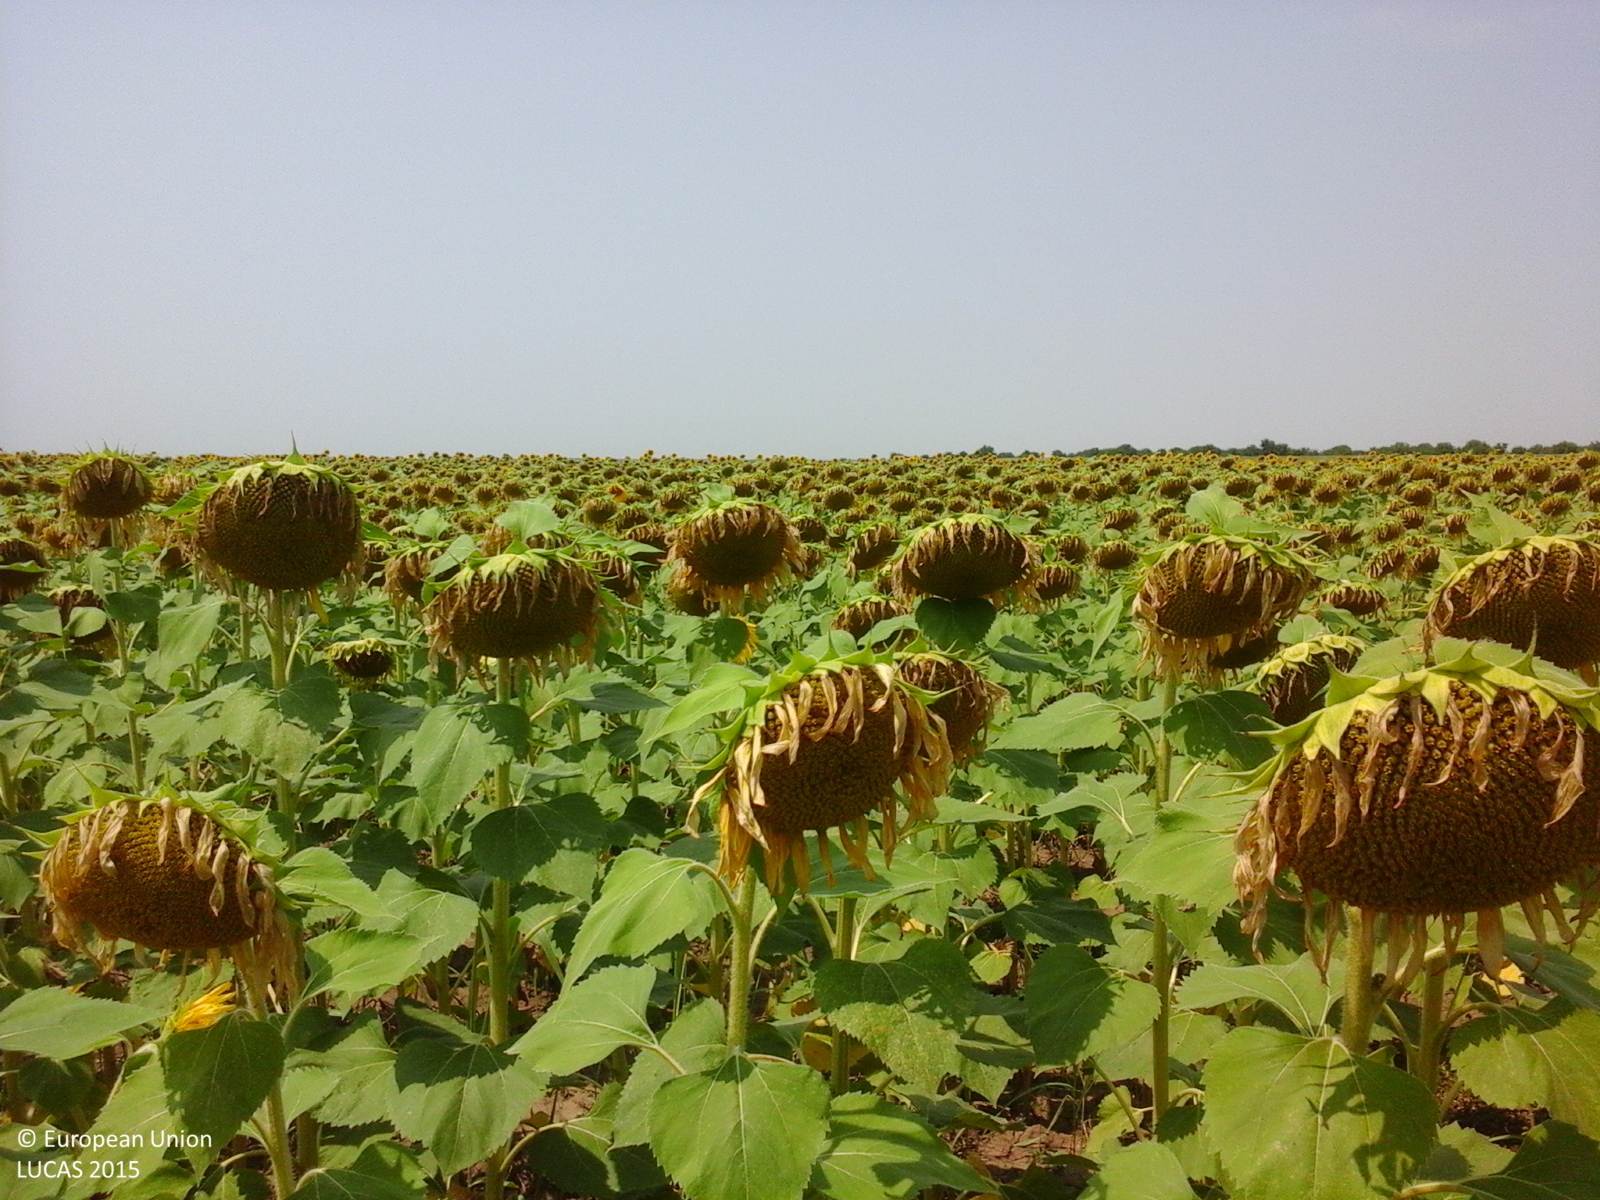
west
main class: Cropland
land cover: Sunflower
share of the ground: > 75 %
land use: Agriculture (excluding fallow land and kitchen gardens)
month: July
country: RO
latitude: 44.6602
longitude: 26.5774
